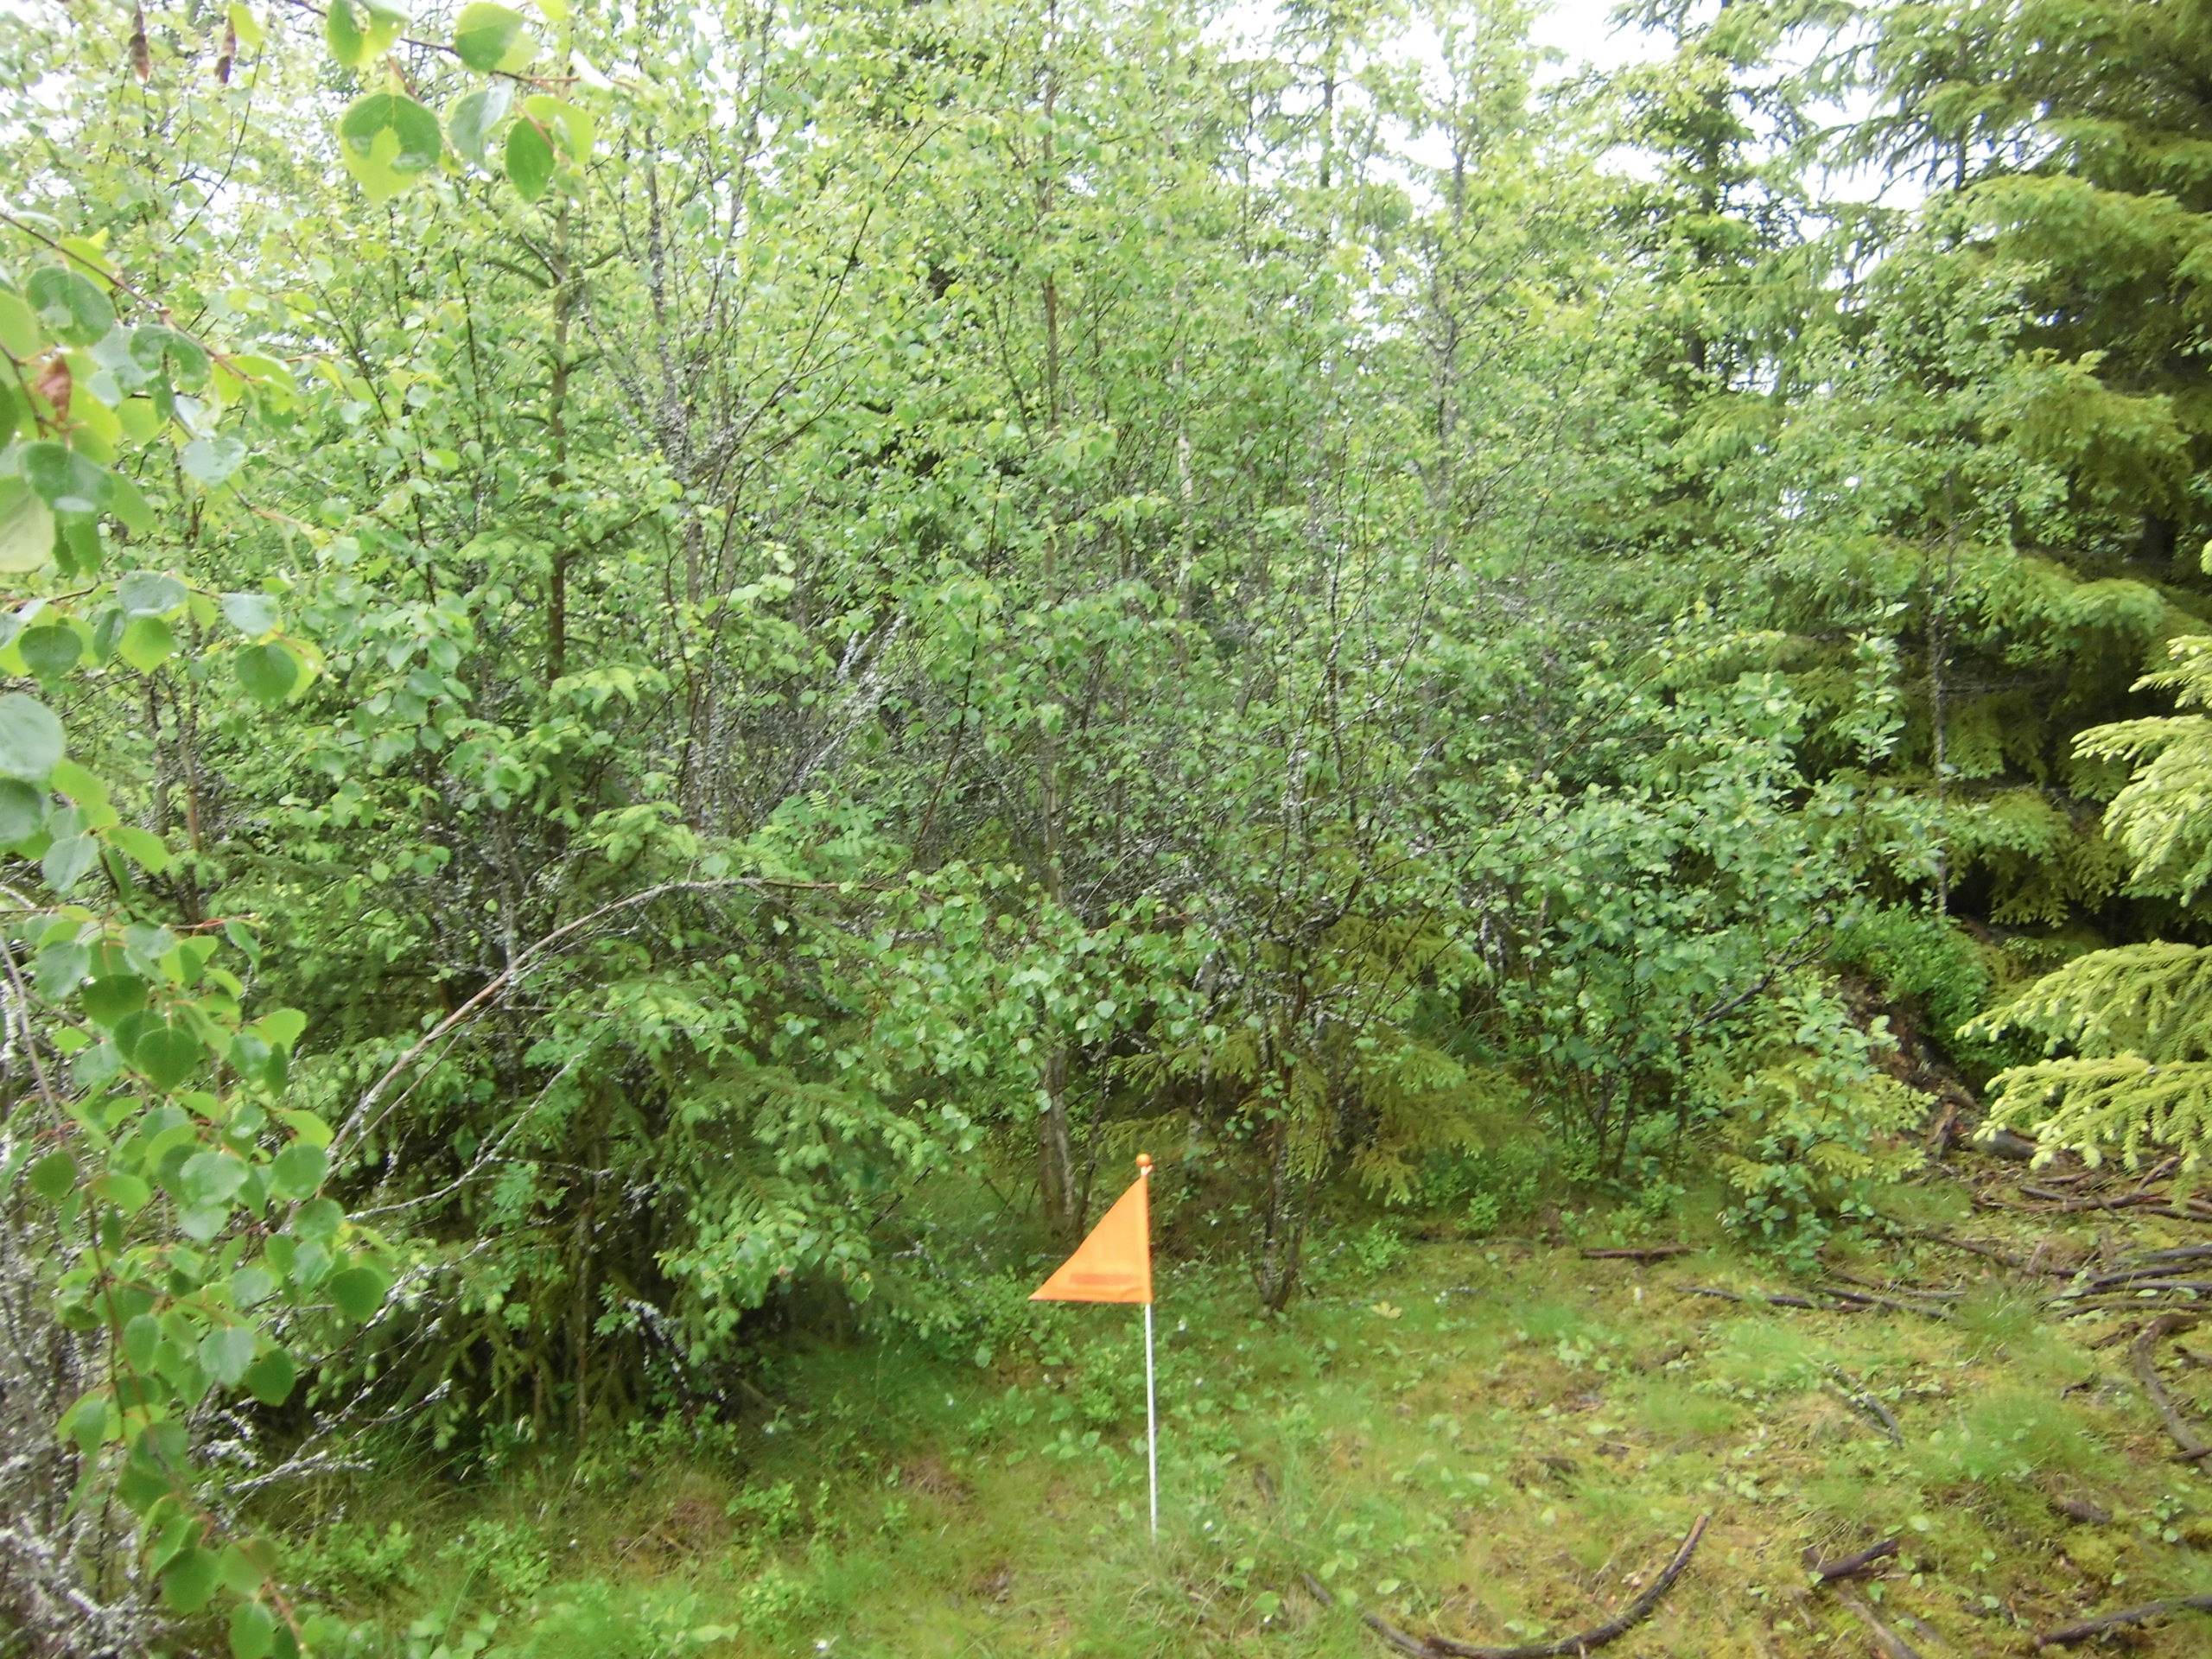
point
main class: Woodland
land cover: Spruce dominated mixed woodland
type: boreal forest
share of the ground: 50 - 75 %
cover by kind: coniferous forest trees 30 %, broadleaved forest trees 30 %, lichens and mosses 20 %, shrubs 10 %, herbaceous plants 10 %
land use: Forestry
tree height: > 5 m
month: June
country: SE
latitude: 57.0597
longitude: 15.0923
